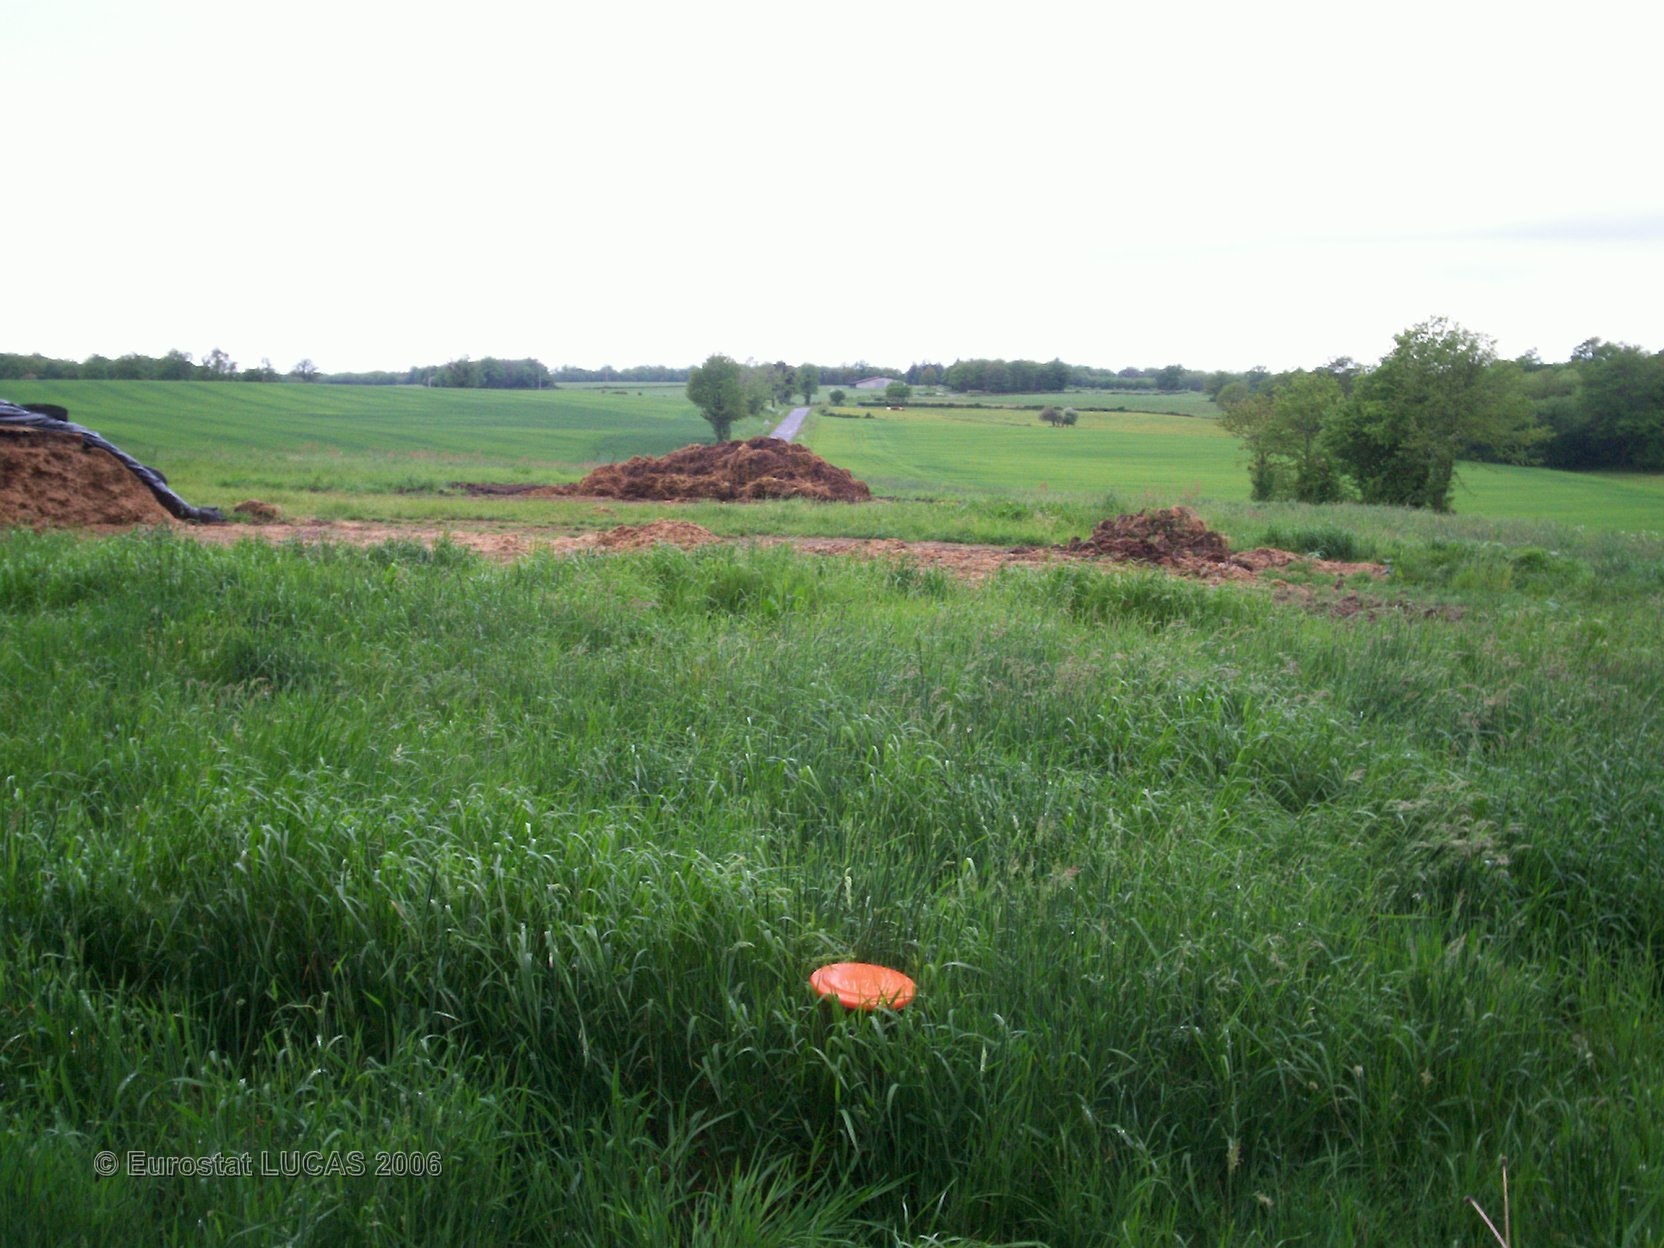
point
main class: Grassland
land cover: Grassland without tree/shrub cover
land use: Logistics and storage
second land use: Agriculture (excluding fallow land and kitchen gardens)
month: May
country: FR
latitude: 46.0306
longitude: 0.4365
